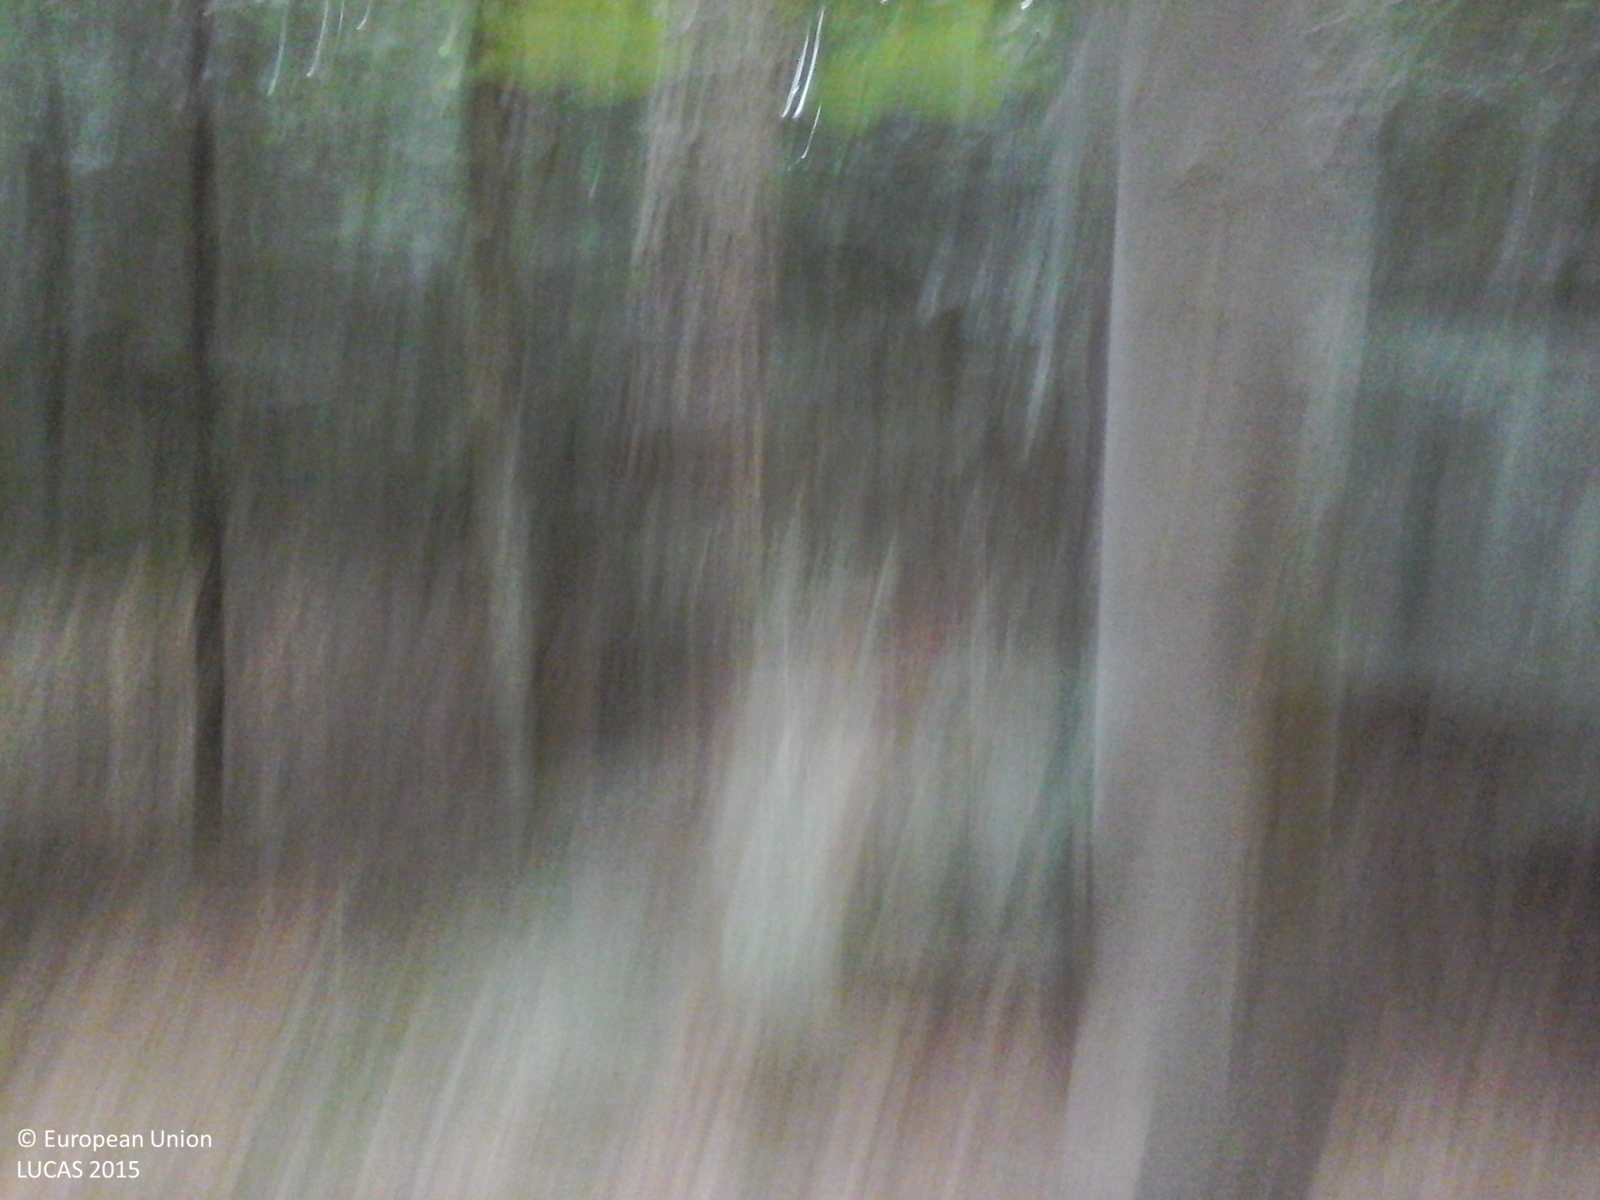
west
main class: Woodland
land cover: Spruce dominated mixed woodland
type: beech forest
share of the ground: > 75 %
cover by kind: coniferous forest trees 50 %, broadleaved forest trees 45 %, shrubs 5 %
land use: Forestry
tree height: > 5 m
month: August
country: IT
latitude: 42.8578
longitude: 11.6226
